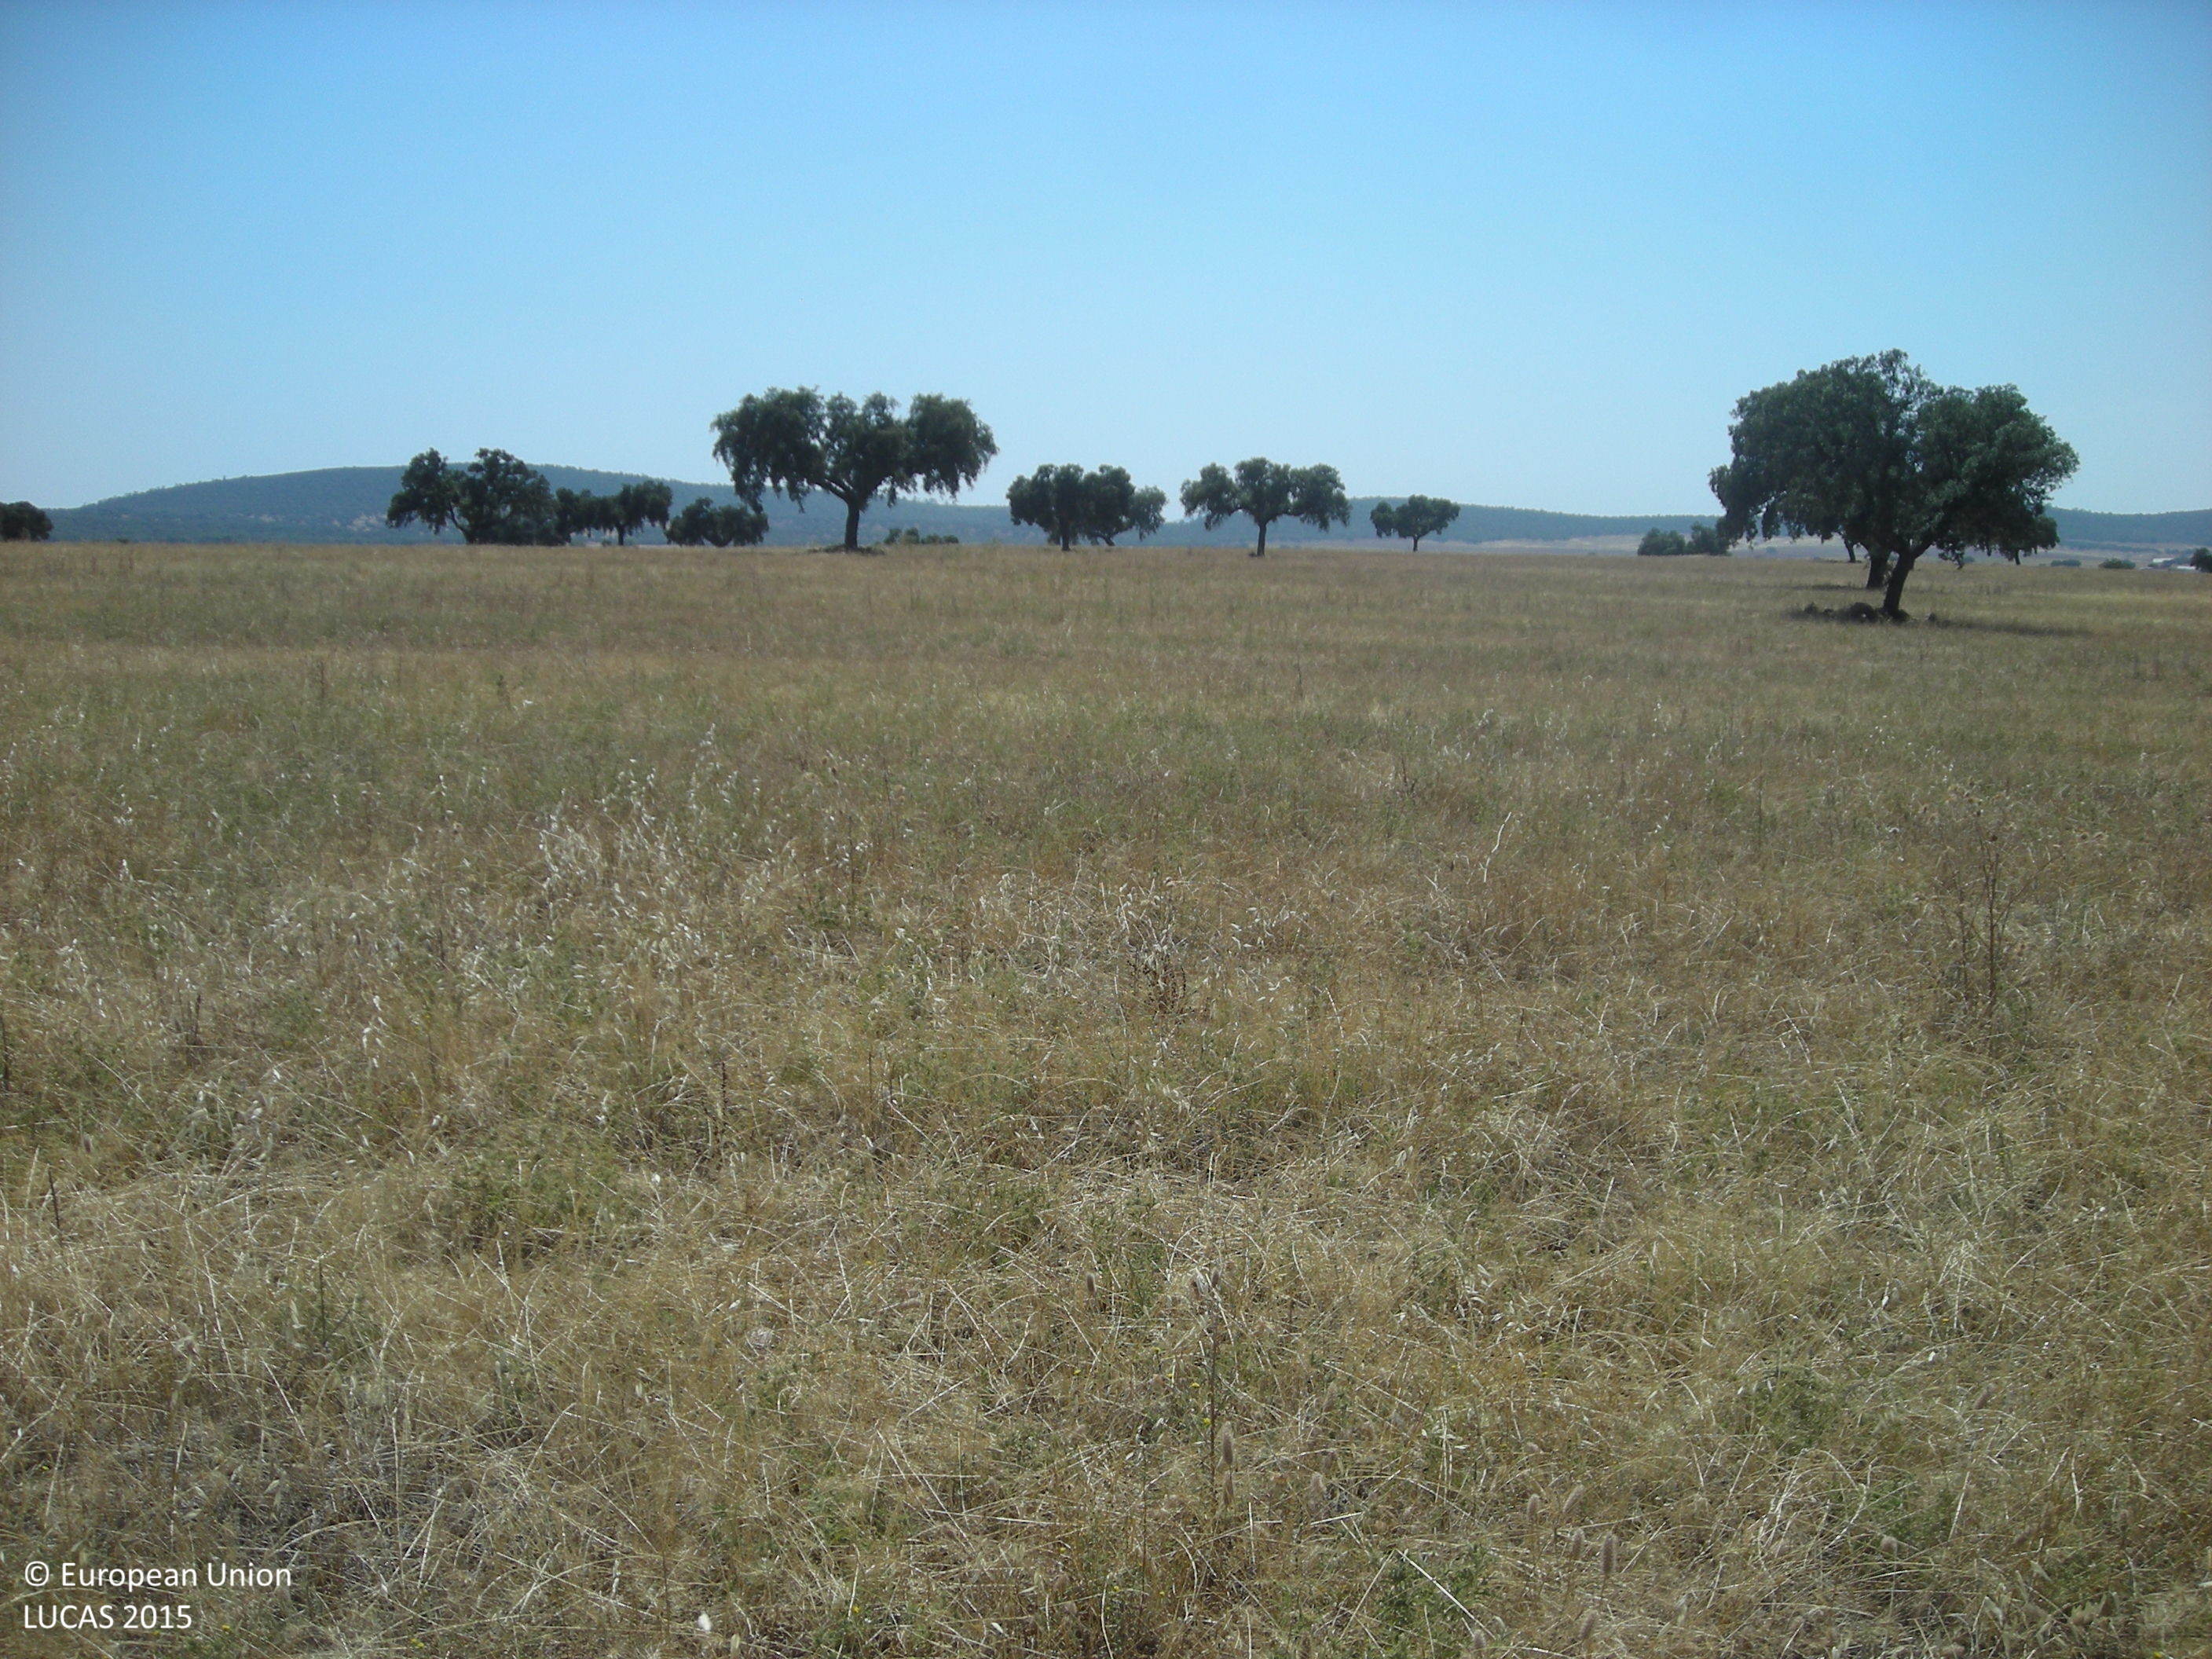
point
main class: Grassland
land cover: Grassland without tree/shrub cover
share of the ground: > 75 %
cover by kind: herbaceous plants 100 %
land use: Agriculture (excluding fallow land and kitchen gardens)
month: June
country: ES
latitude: 38.6148
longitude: -5.8812
